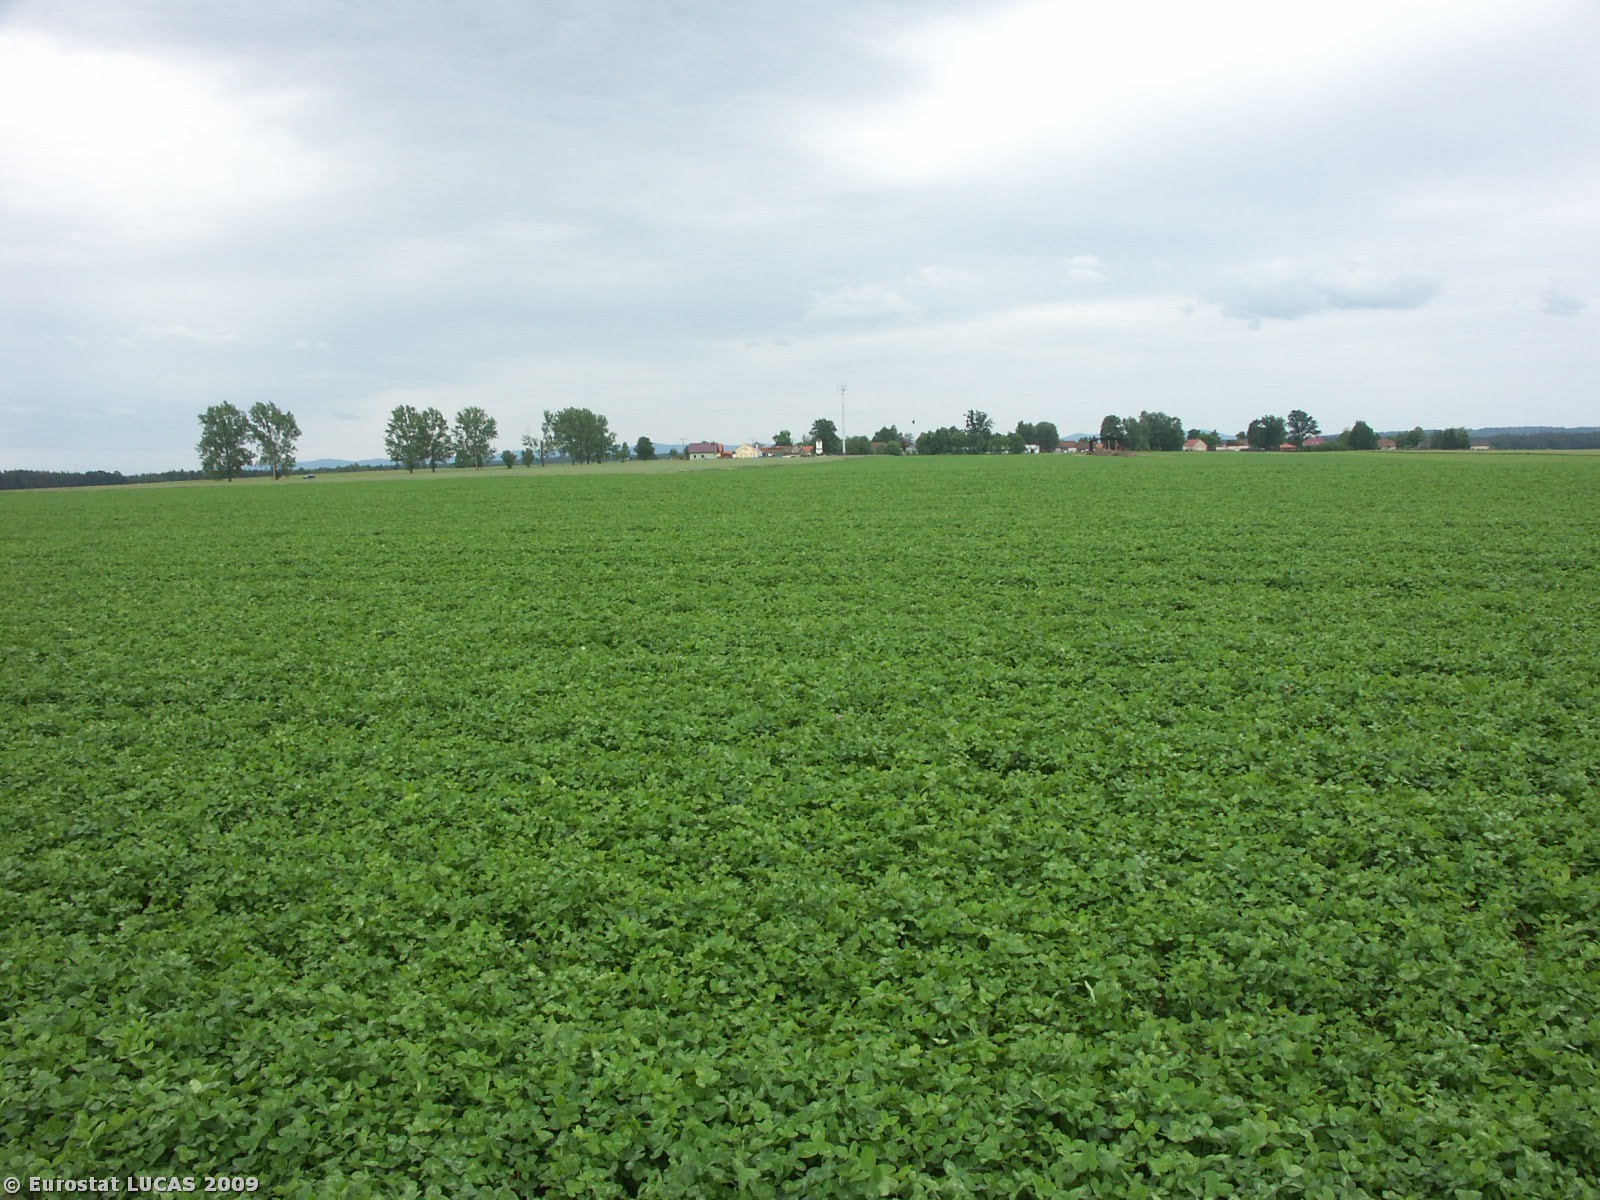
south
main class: Cropland
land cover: Clovers
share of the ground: > 75 %
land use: Agriculture (excluding fallow land and kitchen gardens)
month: June
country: CZ
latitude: 48.9721
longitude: 14.6599
